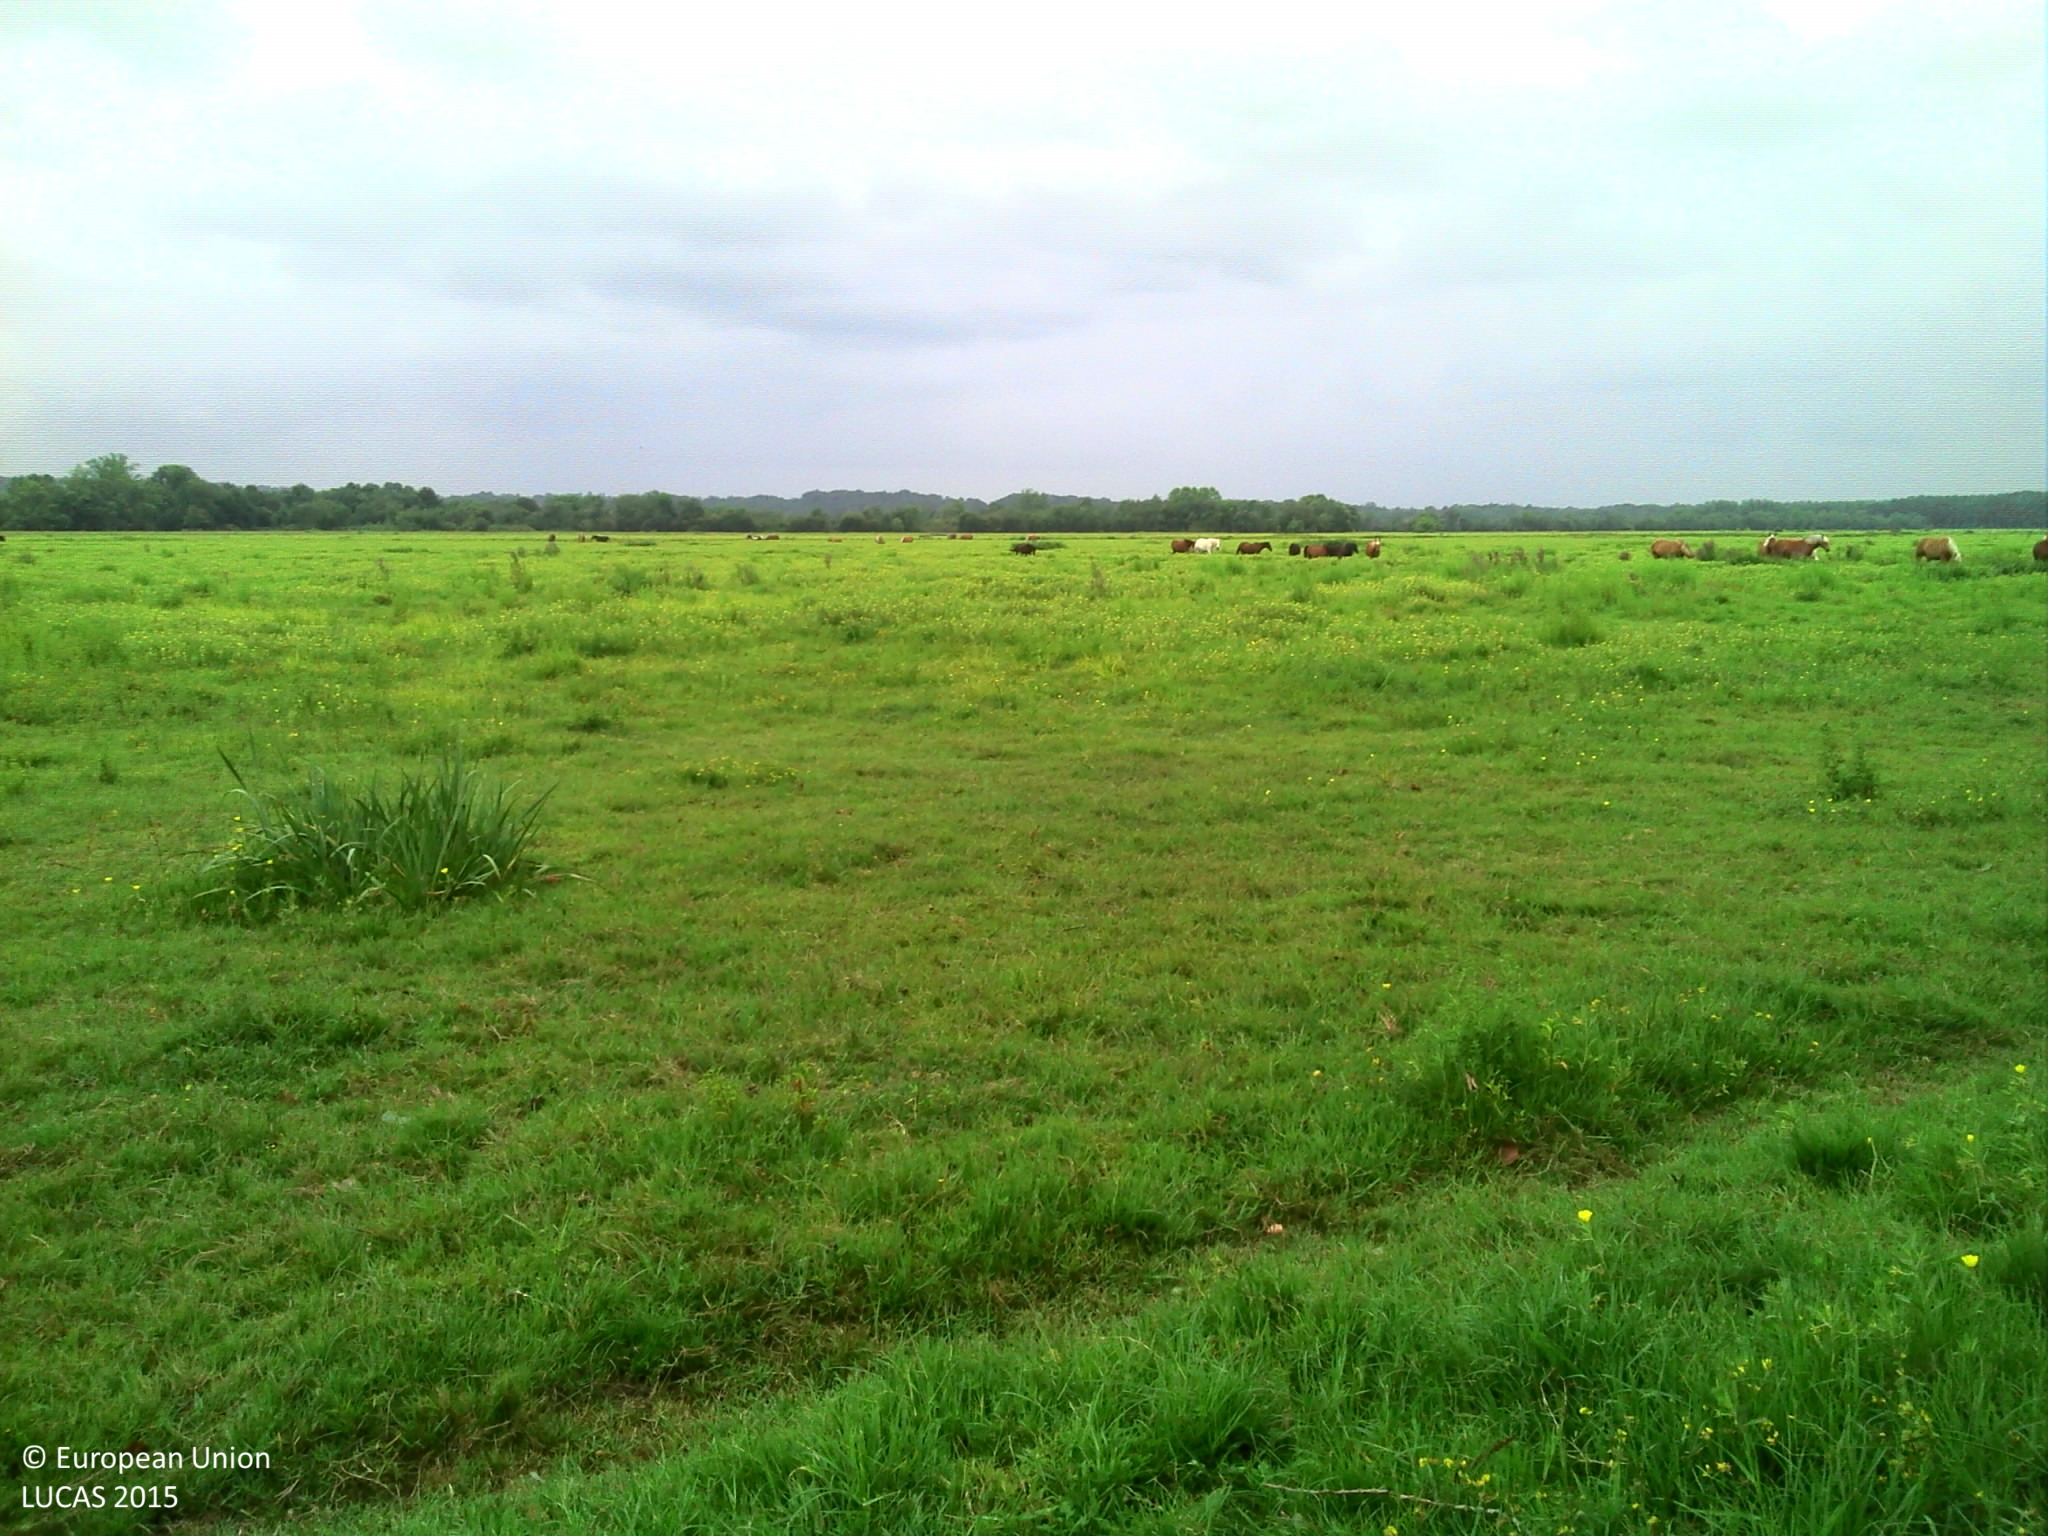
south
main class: Grassland
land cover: Grassland without tree/shrub cover
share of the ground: > 75 %
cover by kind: herbaceous plants 95 %, unconsolidated bare surface 5 %
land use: Agriculture (excluding fallow land and kitchen gardens)
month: July
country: FR
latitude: 43.6731
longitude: -1.1668
